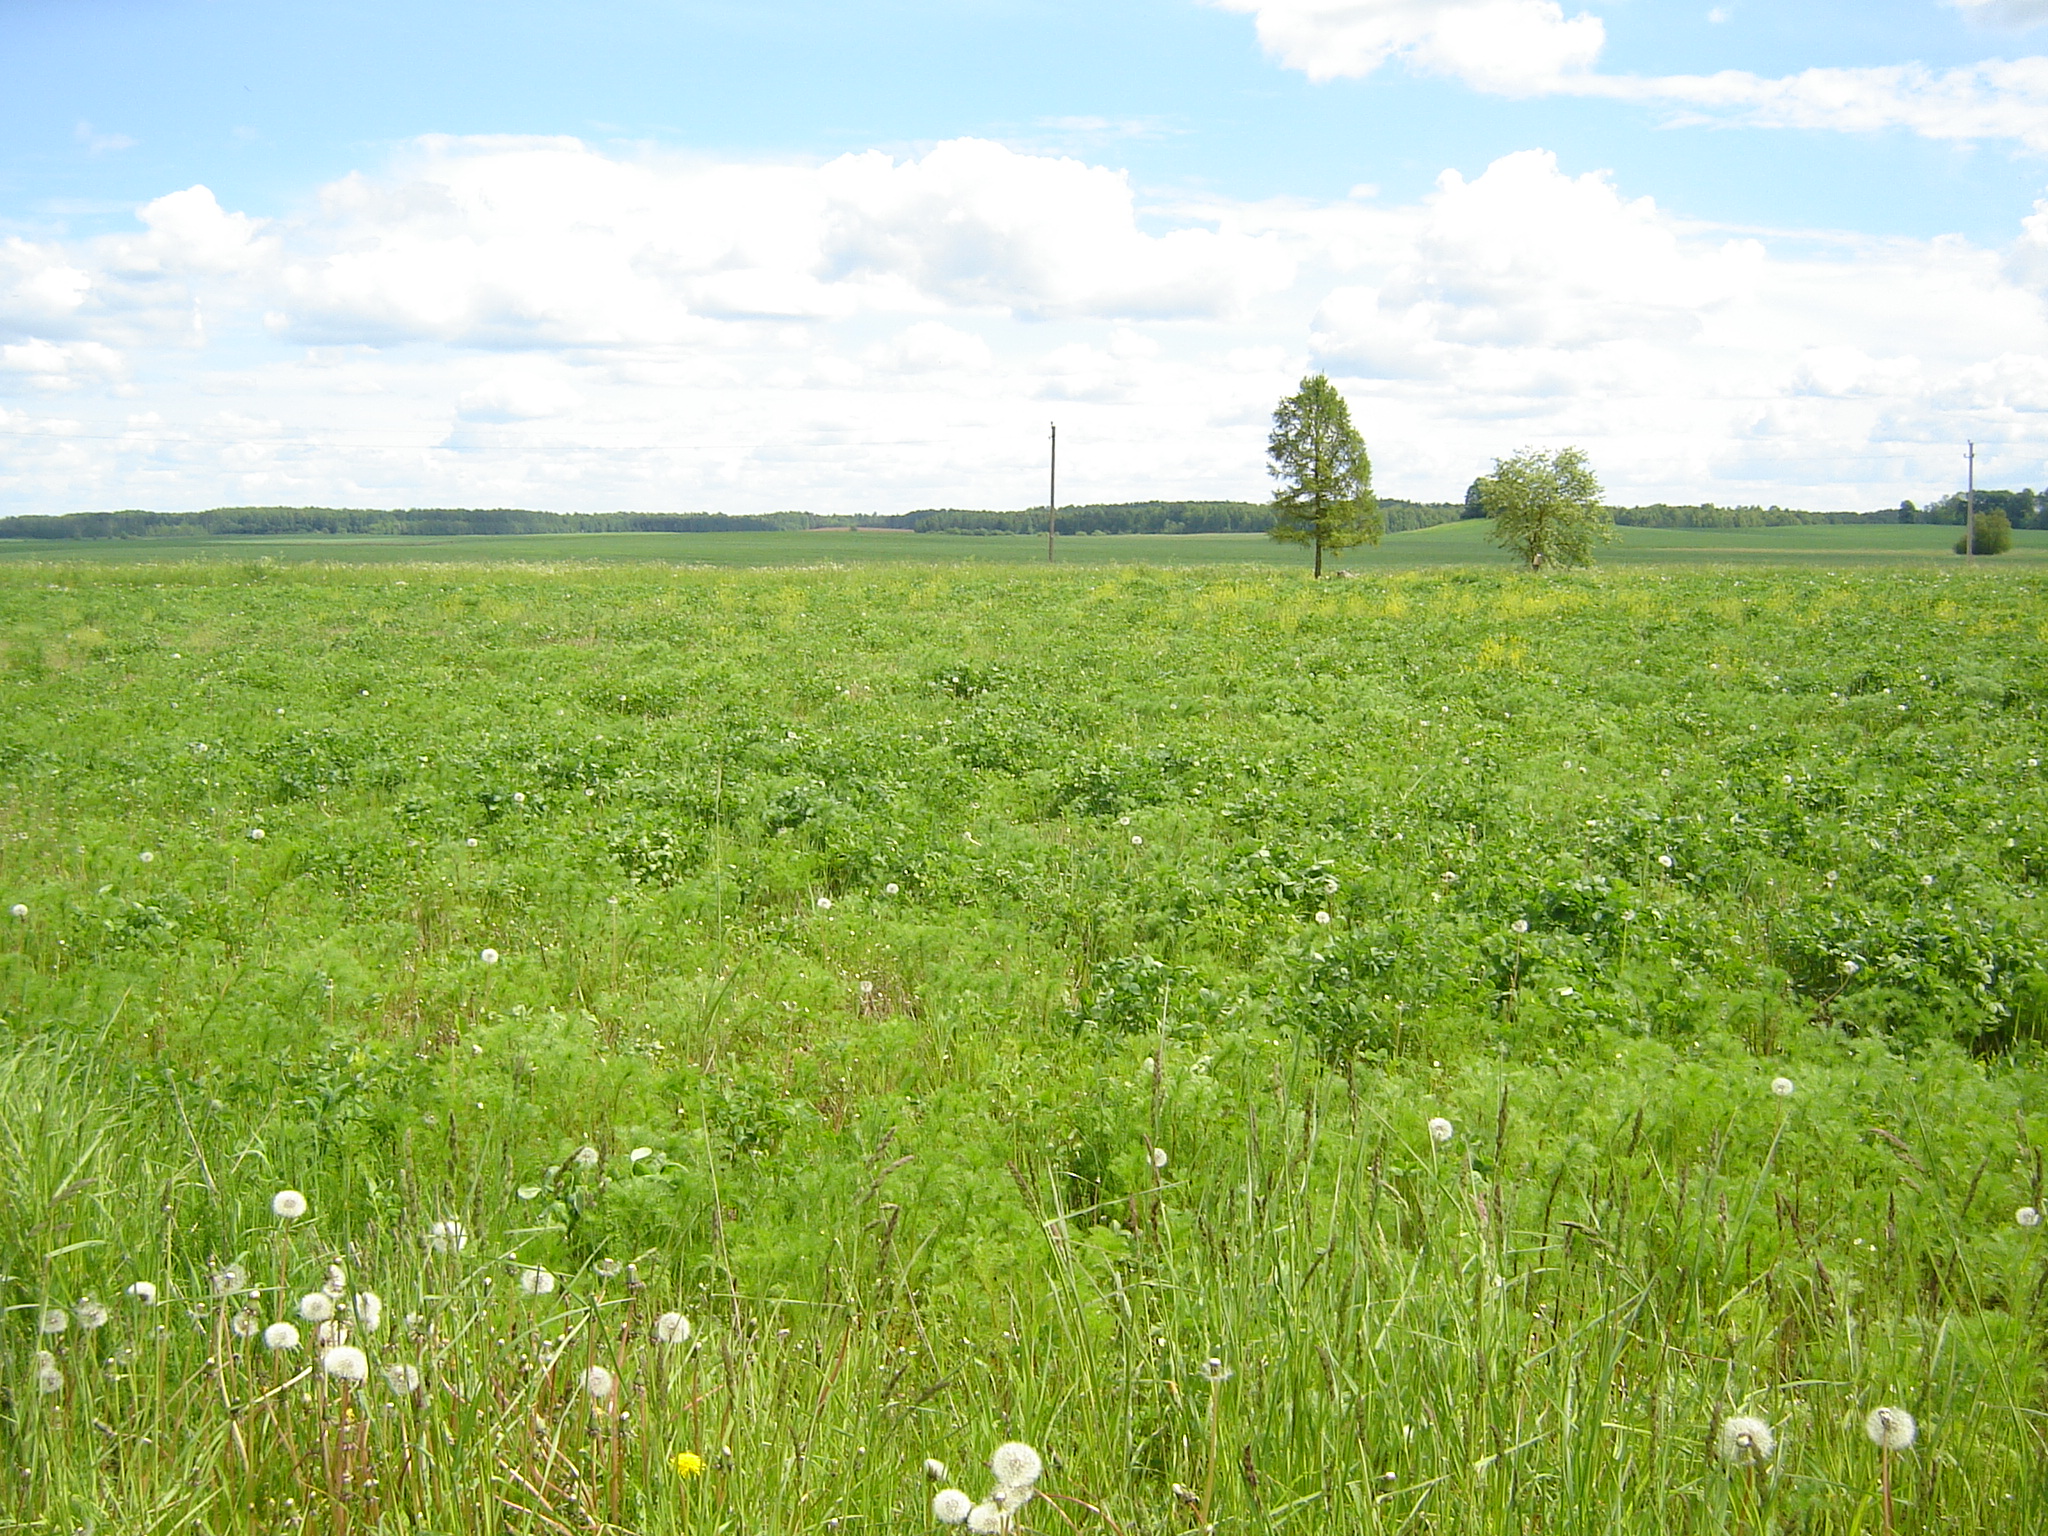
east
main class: Grassland
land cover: Grassland without tree/shrub cover
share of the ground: > 75 %
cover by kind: herbaceous plants 100 %
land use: Agriculture (excluding fallow land and kitchen gardens)
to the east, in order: Grassland without tree/shrub cover; Grass margins; Paved roads, cycling and walking lanes; Grass margins; Barley; Electric lines; Barley
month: May
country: LT
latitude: 55.8246
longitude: 25.2000
